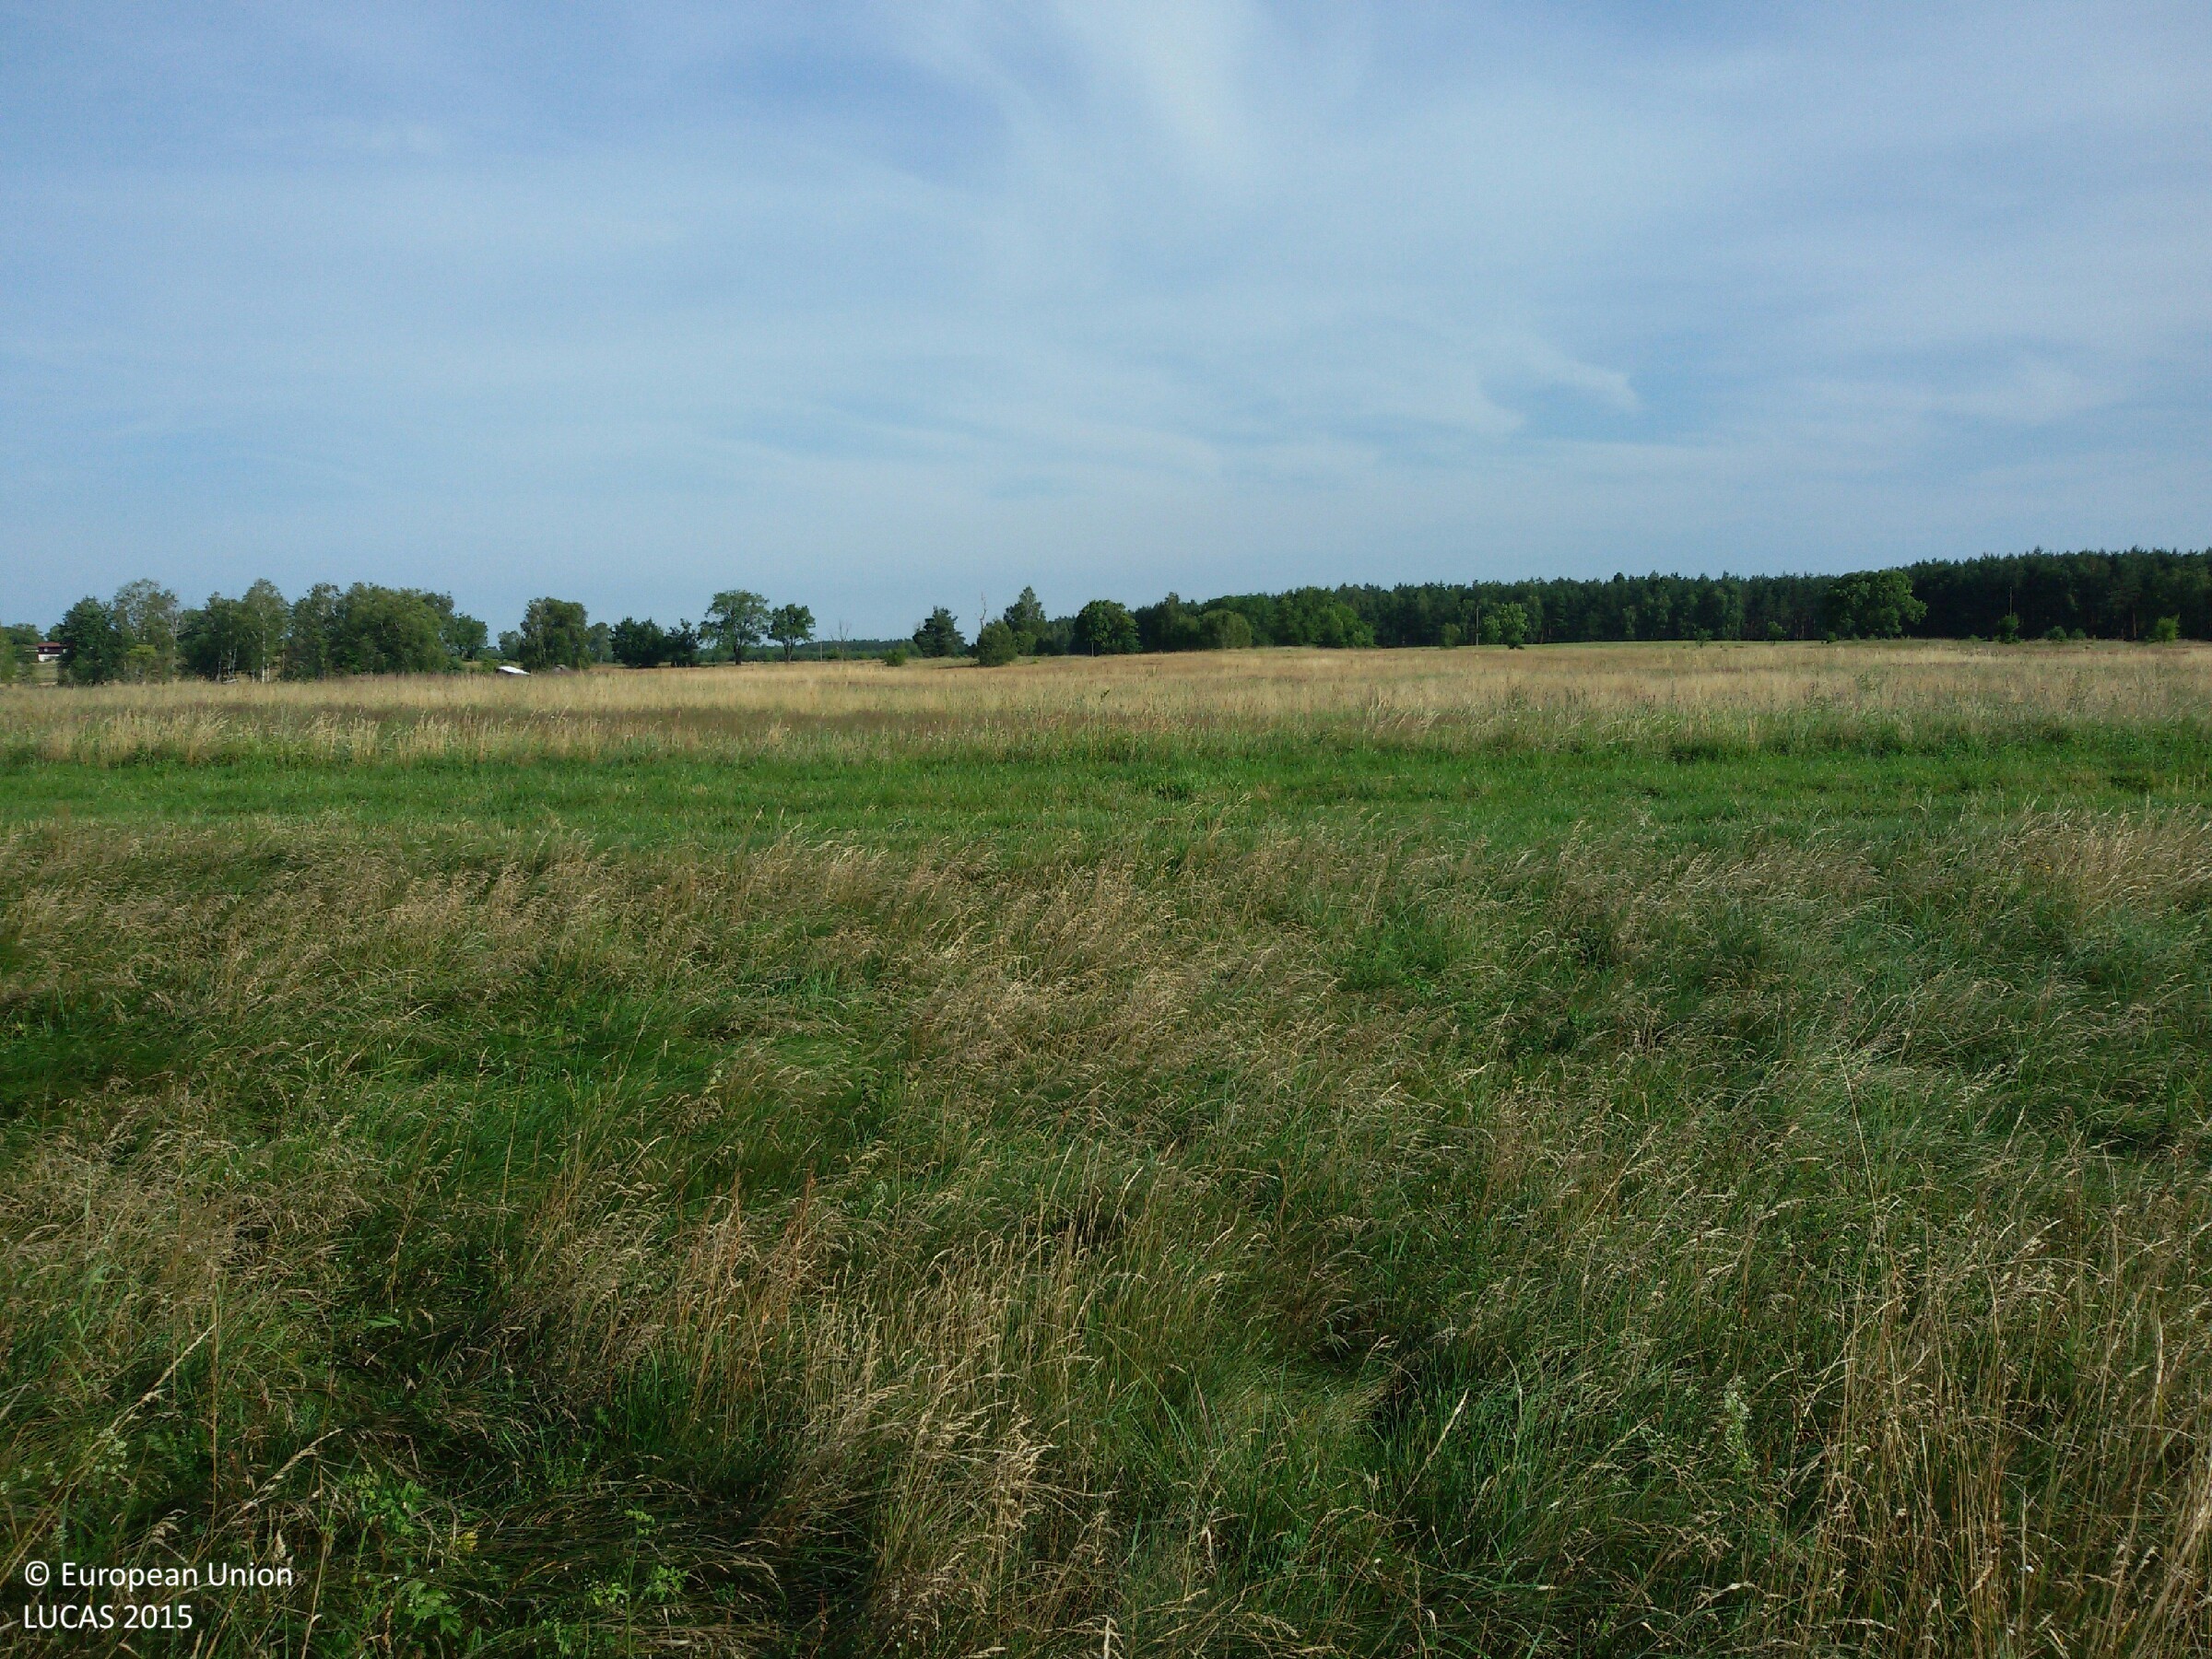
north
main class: Grassland
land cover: Grassland without tree/shrub cover
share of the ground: > 75 %
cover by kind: herbaceous plants 100 %
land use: Agriculture (excluding fallow land and kitchen gardens)
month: July
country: PL
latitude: 53.1416
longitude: 15.7000
